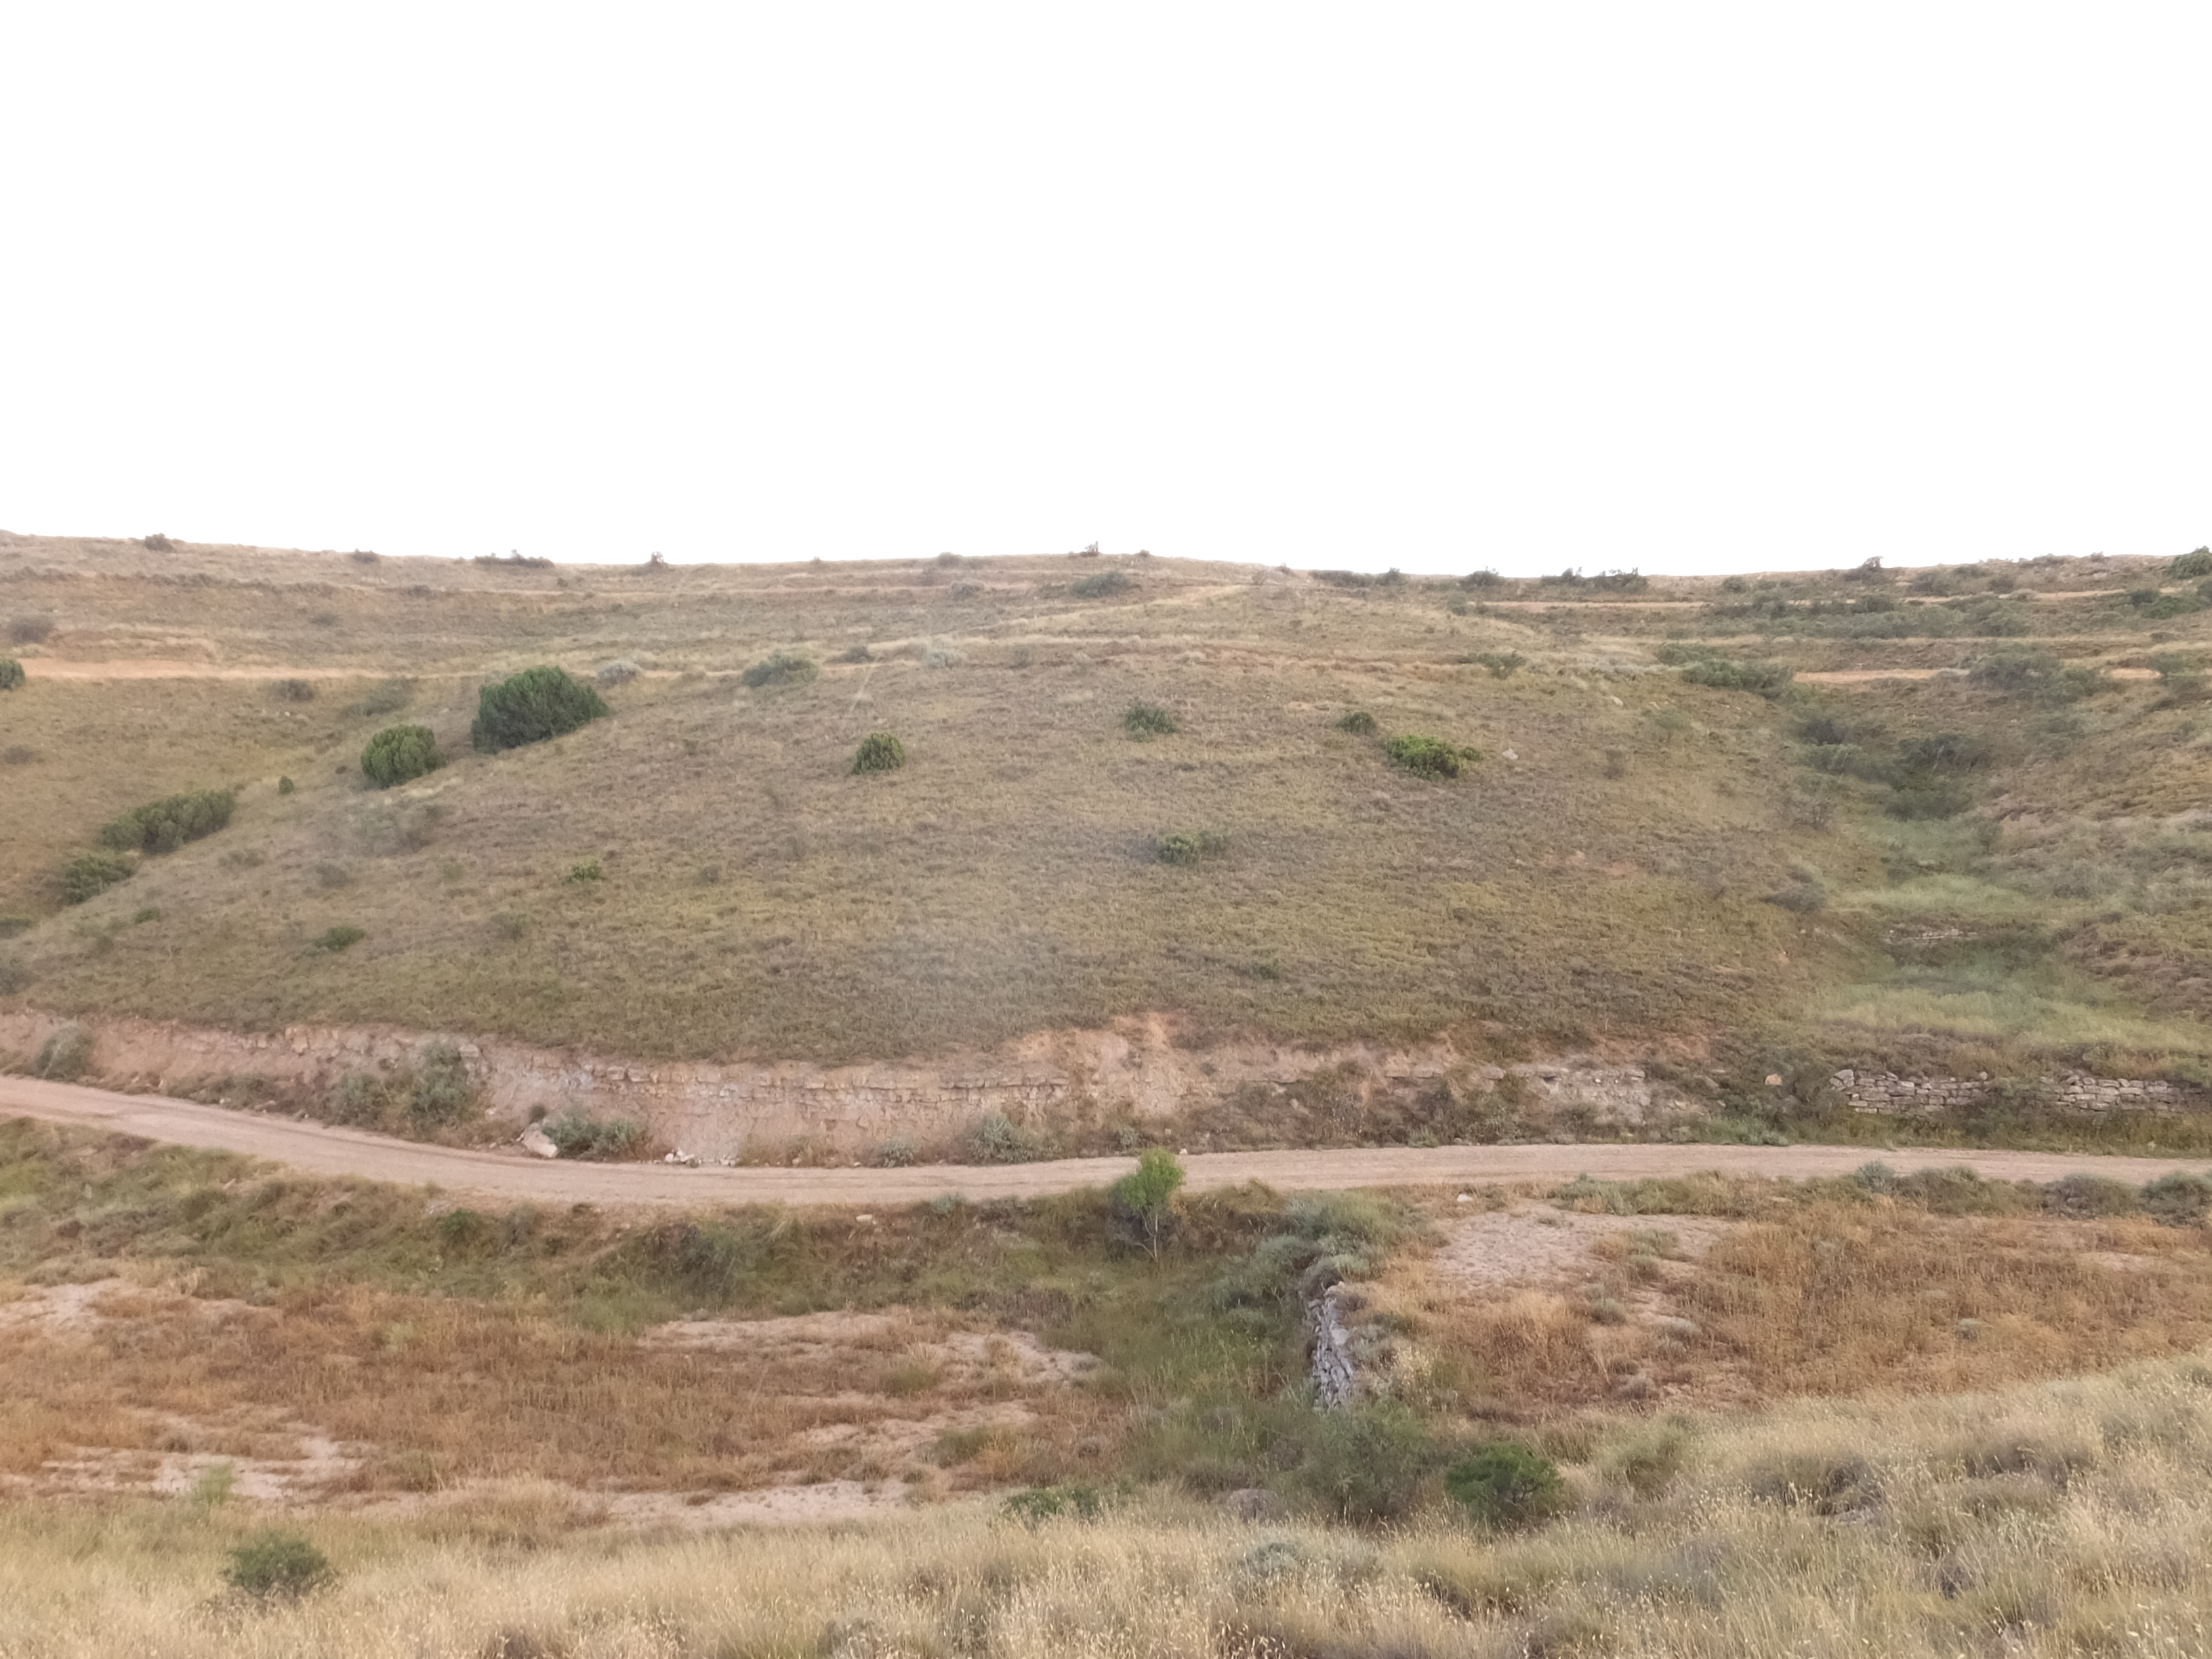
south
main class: Shrubland
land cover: Shrubland without tree cover
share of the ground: 50 - 75 %
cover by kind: shrubs 50 %, herbaceous plants 40 %, consolidated bare surface 10 %
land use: Semi-natural and natural areas not in use
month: June
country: ES
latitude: 41.6696
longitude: 0.0272
